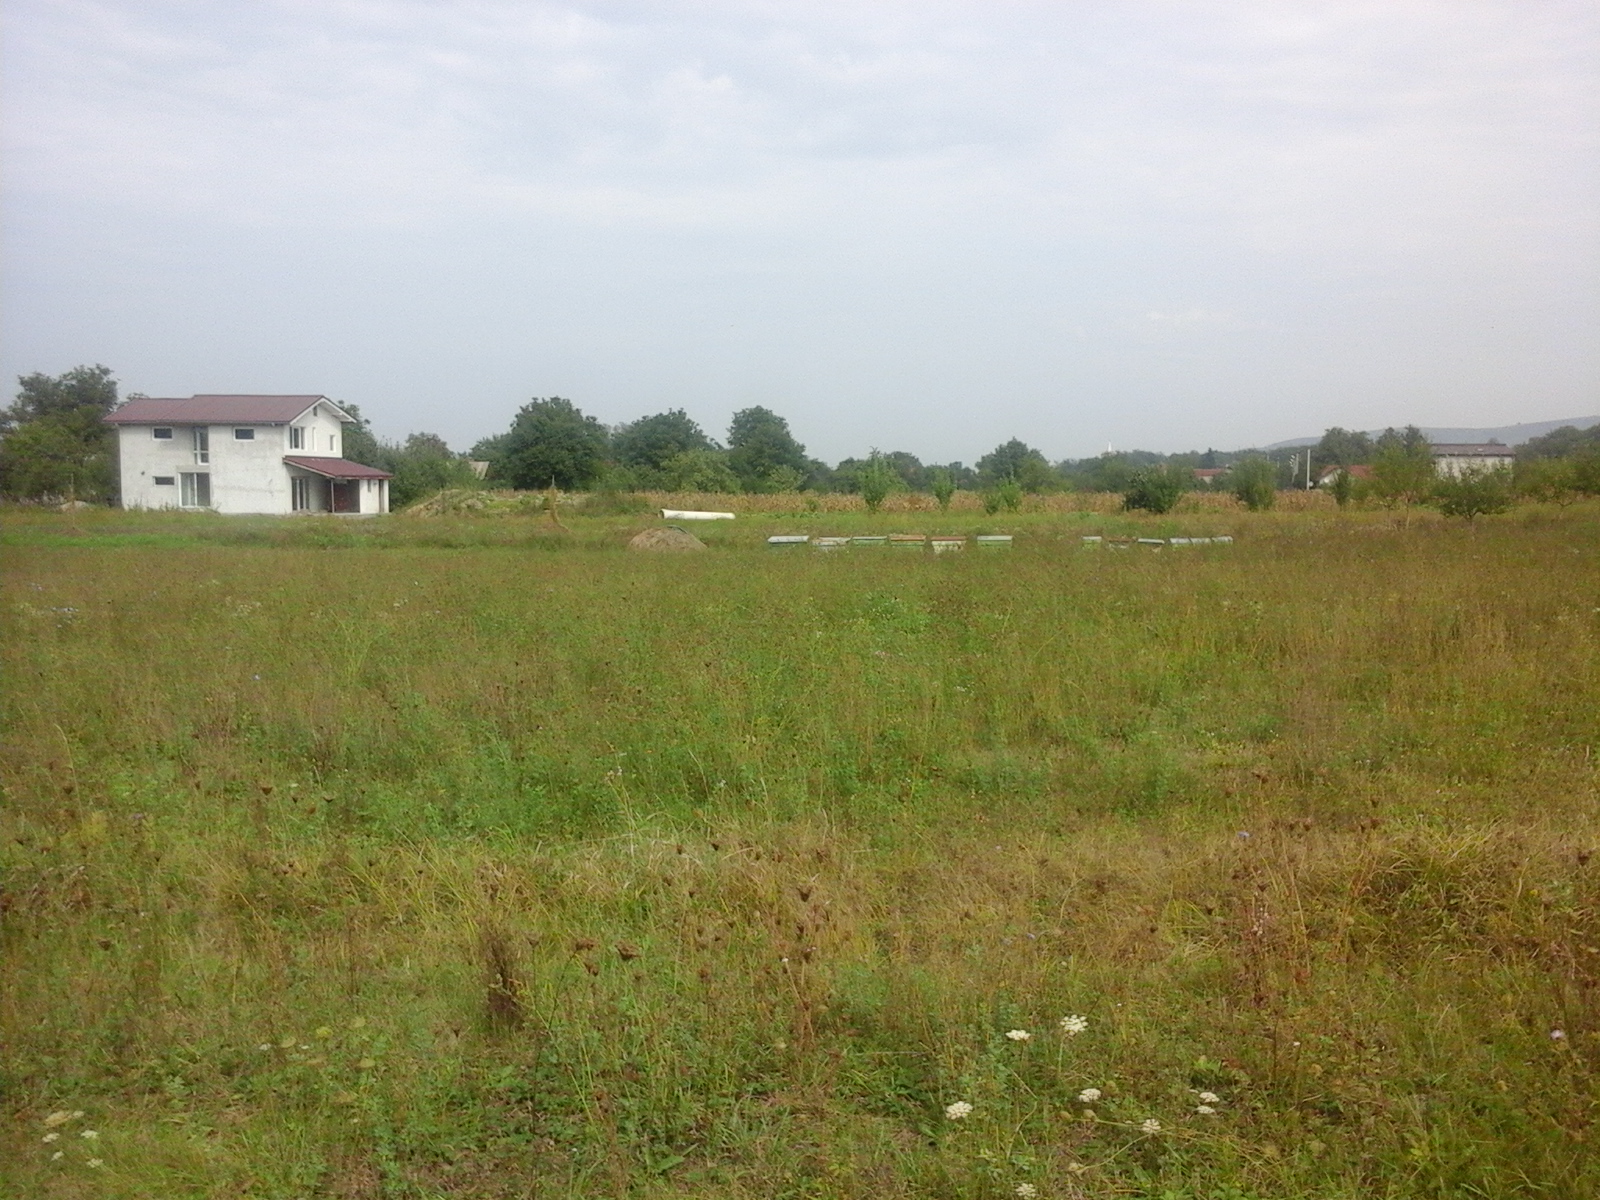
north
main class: Grassland
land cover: Spontaneously vegetated surfaces
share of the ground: > 75 %
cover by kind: herbaceous plants 100 %
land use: Agriculture (excluding fallow land and kitchen gardens)
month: September
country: RO
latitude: 45.7159
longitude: 23.0170
